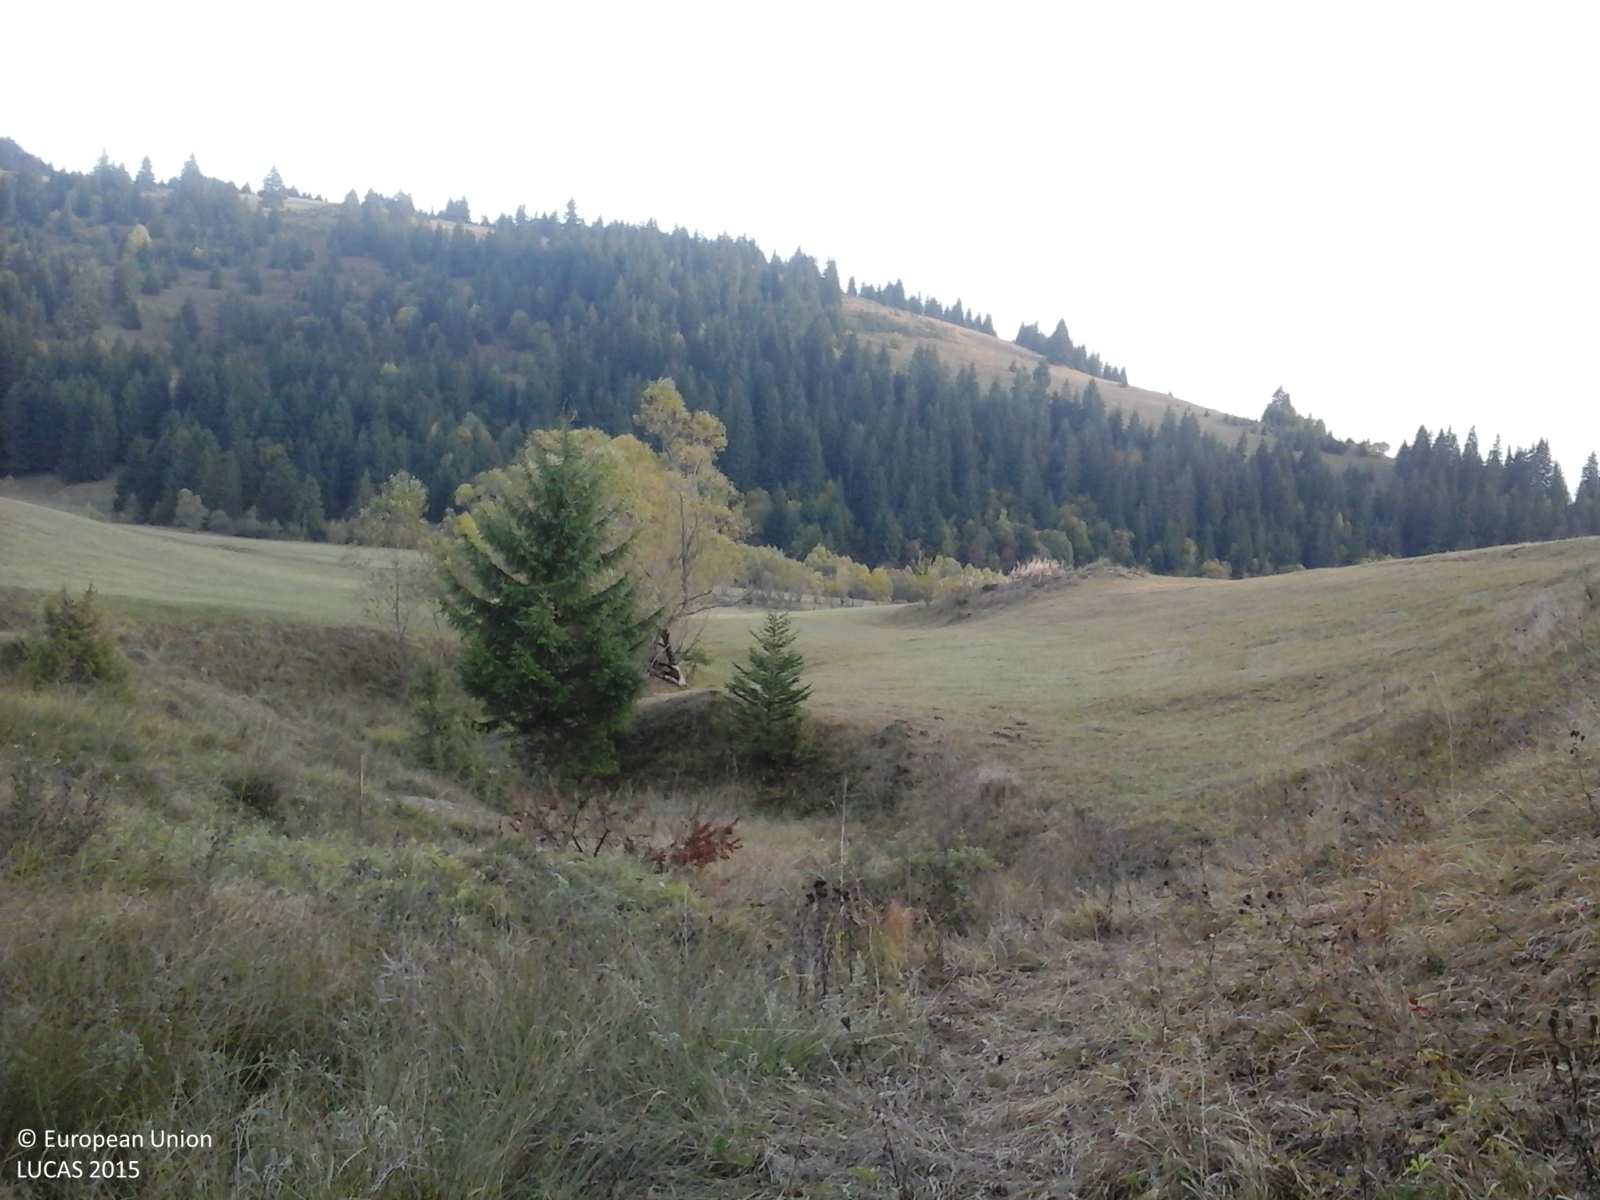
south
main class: Grassland
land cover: Spontaneously vegetated surfaces
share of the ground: > 75 %
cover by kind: herbaceous plants 100 %
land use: Fallow land
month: October
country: RO
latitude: 46.3927
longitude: 25.9456
